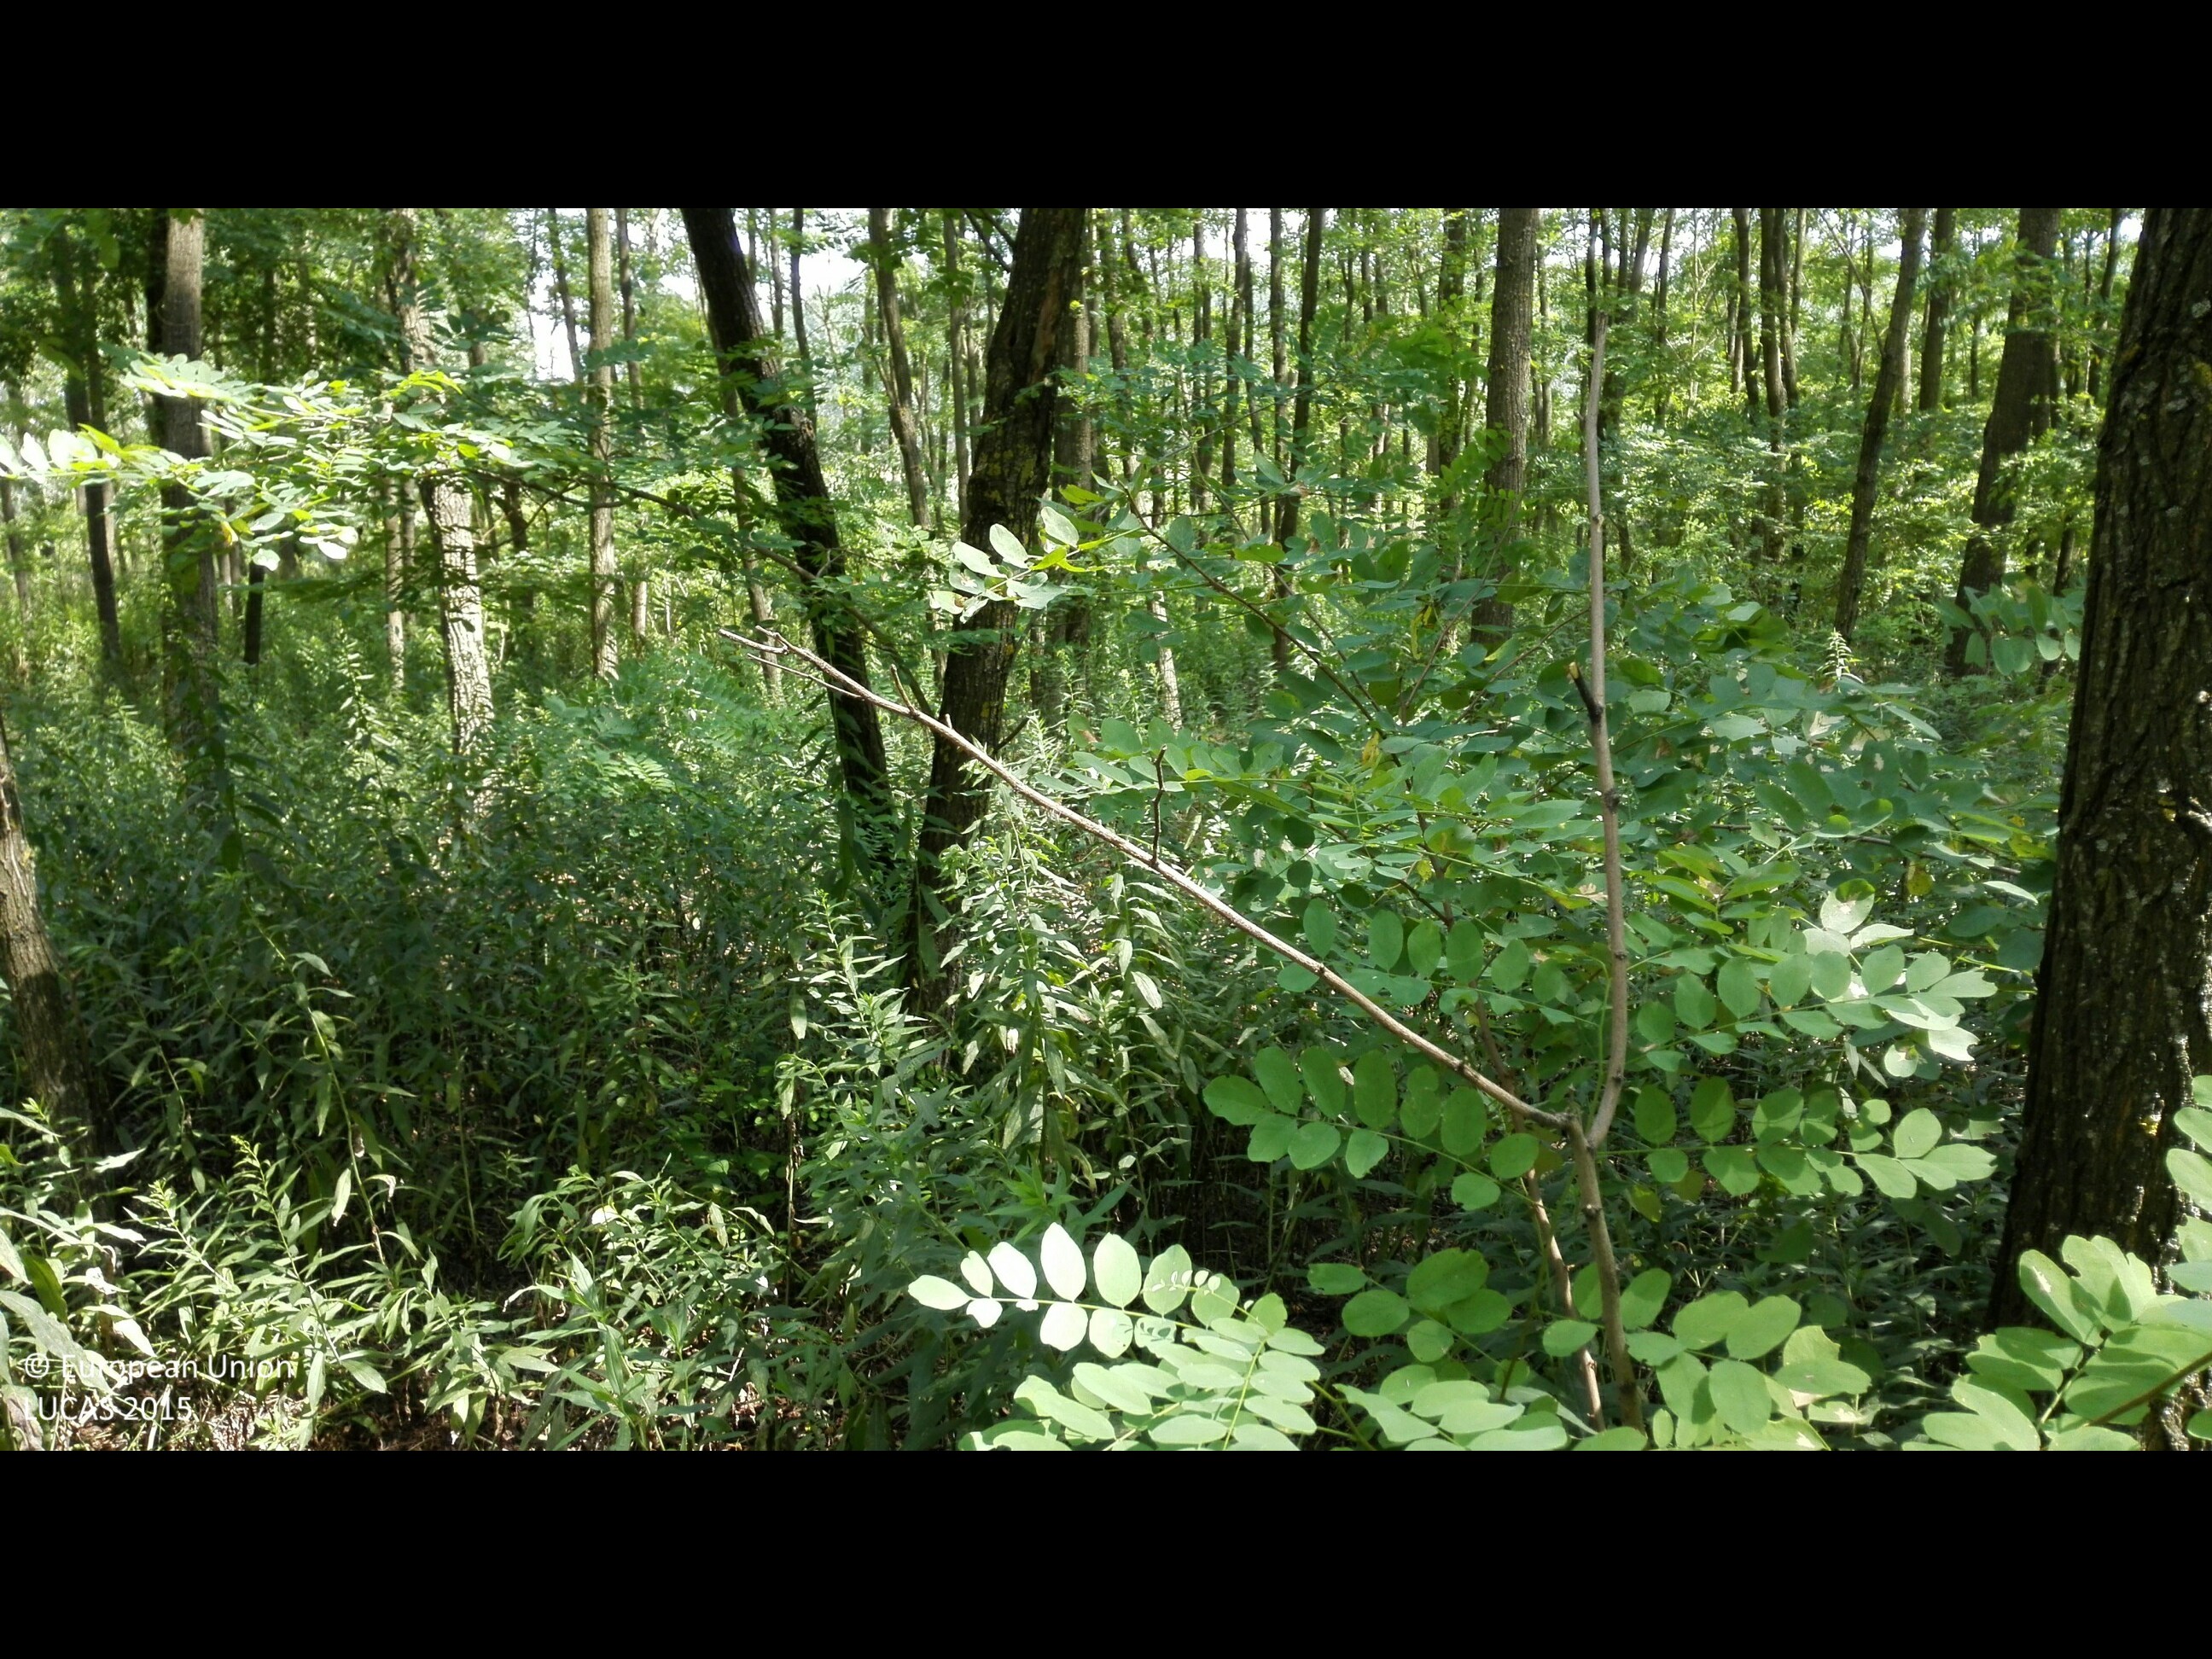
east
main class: Woodland
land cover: Broadleaved woodland
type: exotic forest
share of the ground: > 75 %
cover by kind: broadleaved forest trees 95 %, herbaceous plants 5 %
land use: Forestry
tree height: > 5 m
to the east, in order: Broadleaved woodland; Tracks; Grass margins; Ditches and canals; Grass margins; Maize; Grass margins; Tracks; Broadleaved woodland; Fences; Broadleaved woodland
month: August
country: HU
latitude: 47.6686
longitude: 21.8884
